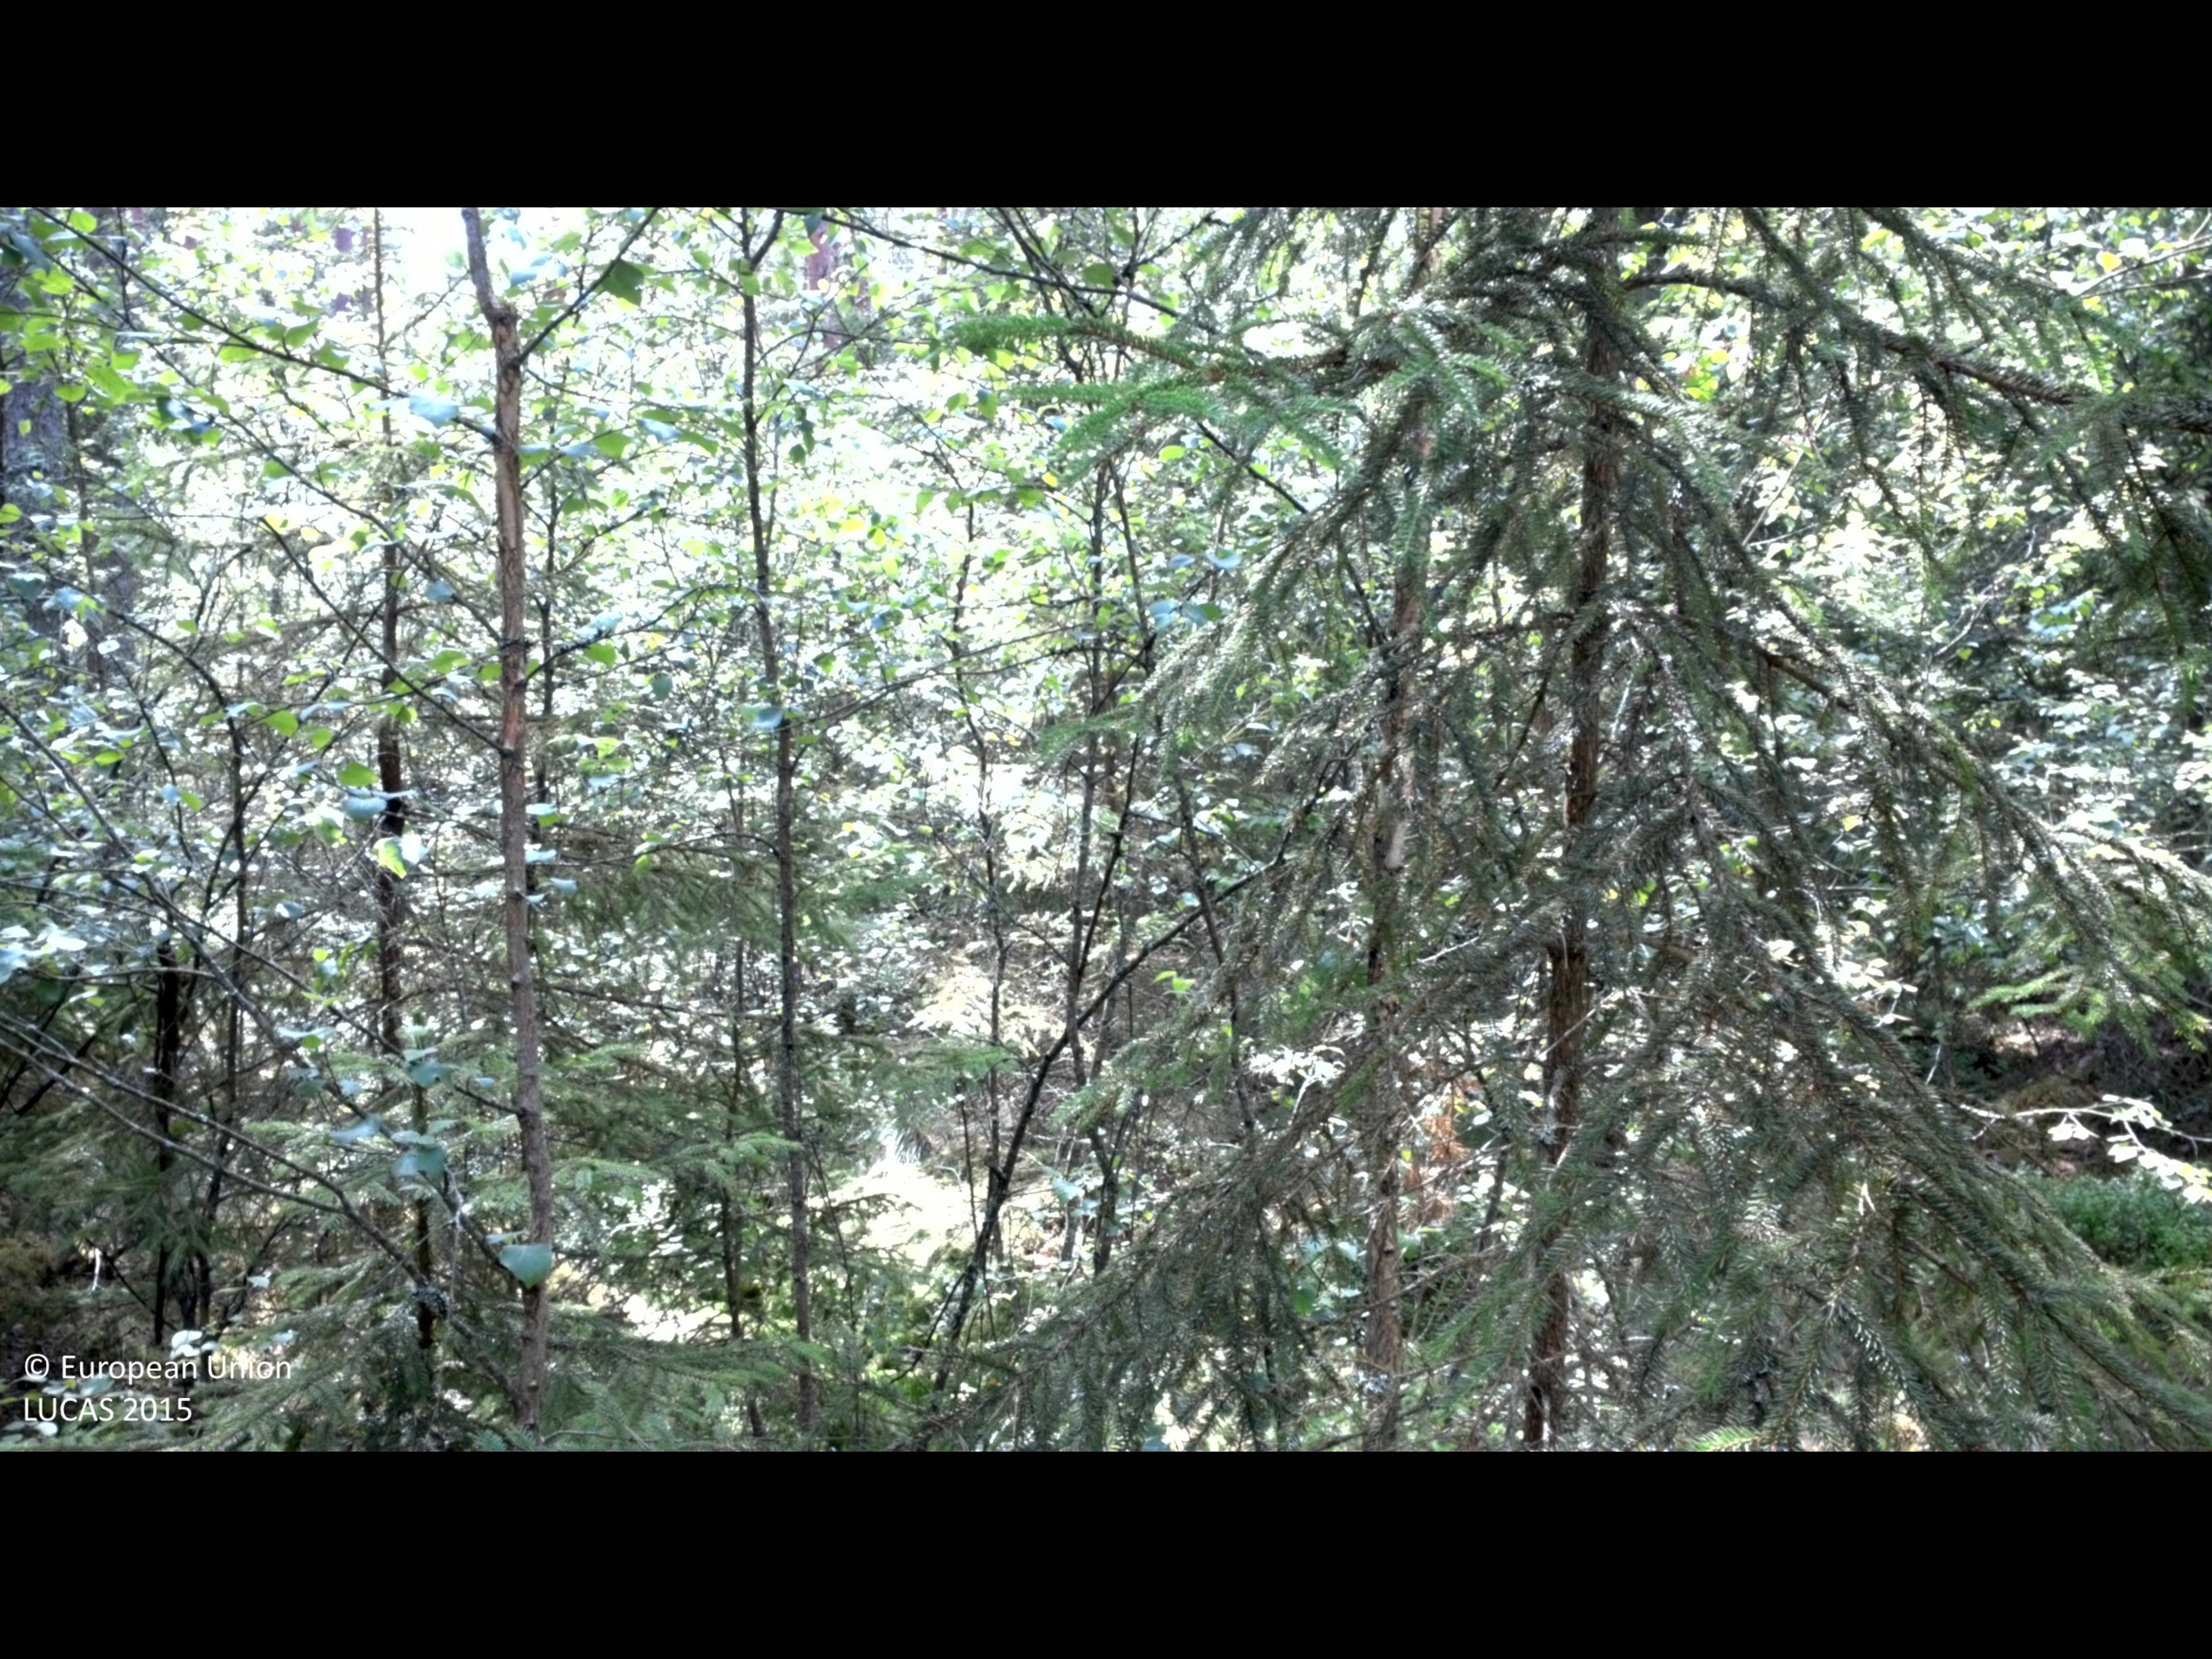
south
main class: Woodland
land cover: Other mixed woodland
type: boreal forest
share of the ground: > 75 %
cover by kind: coniferous forest trees 50 %, broadleaved forest trees 30 %, shrubs 15 %, lichens and mosses 5 %
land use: Forestry
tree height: > 5 m
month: July
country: SE
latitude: 56.4357
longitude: 14.4250
